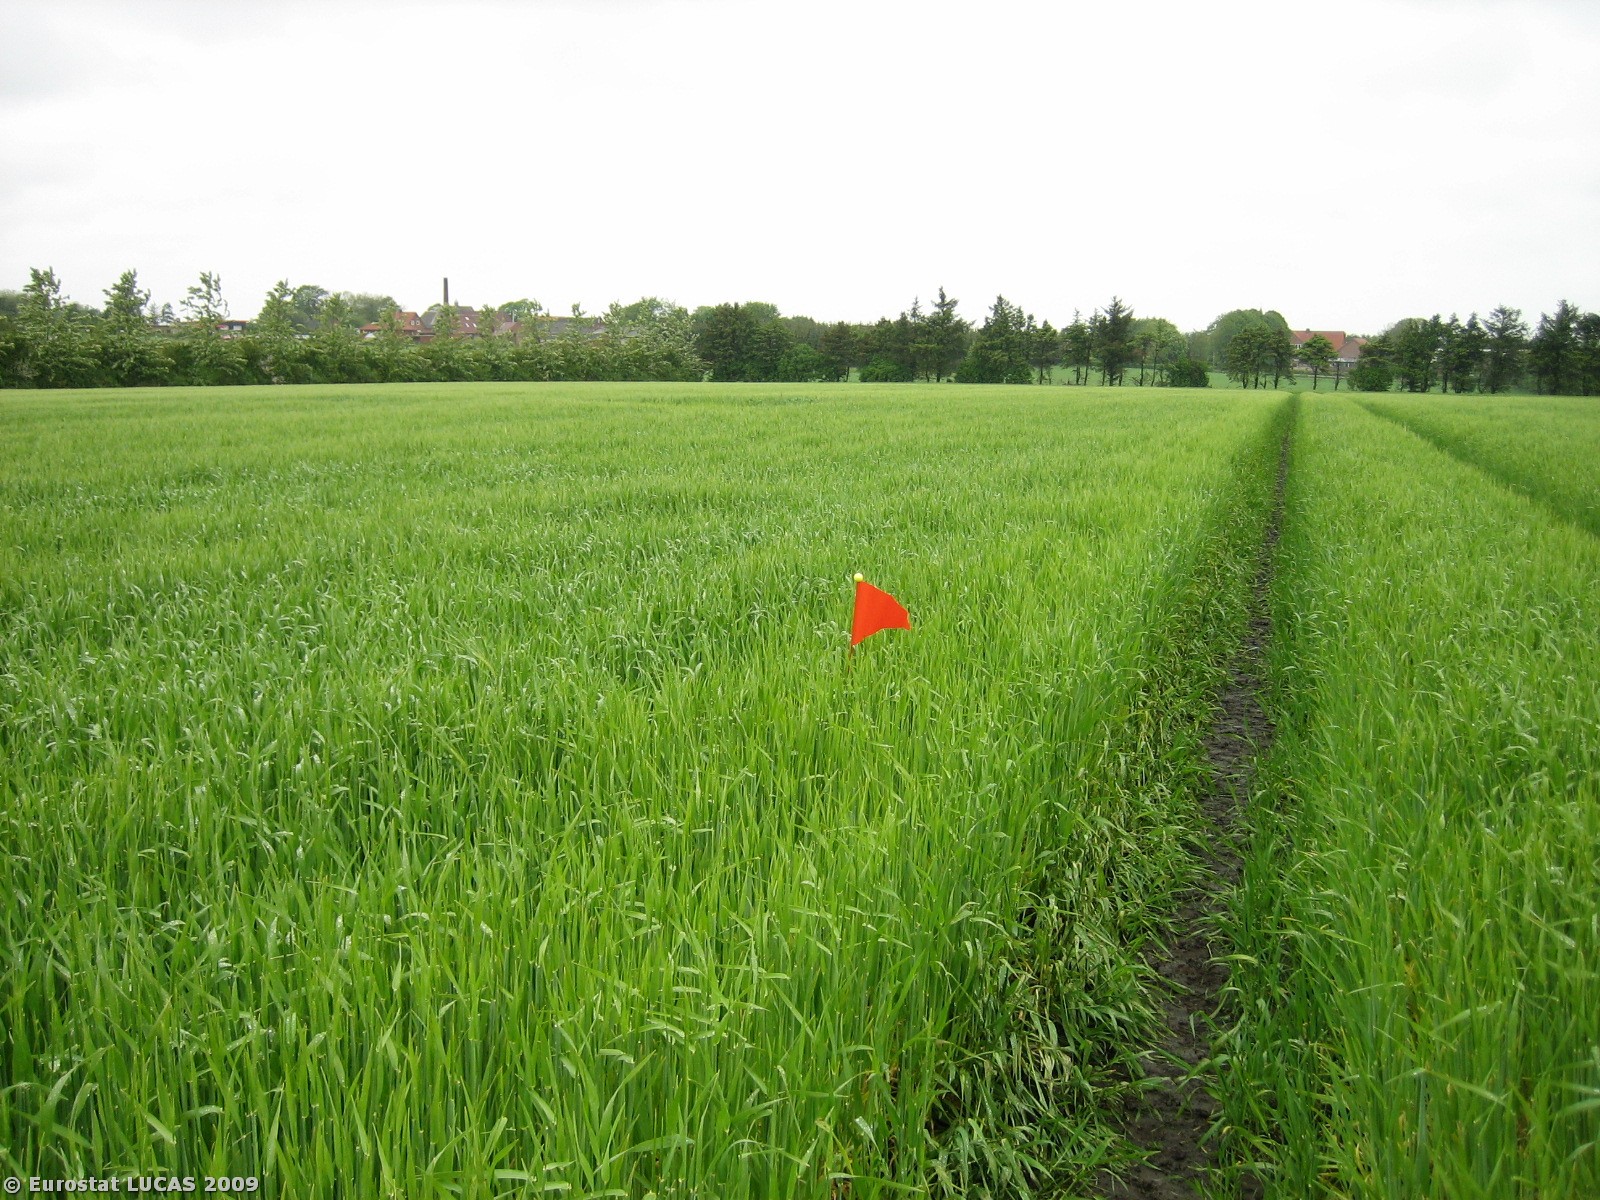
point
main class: Cropland
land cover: Barley
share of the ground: > 75 %
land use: Agriculture (excluding fallow land and kitchen gardens)
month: May
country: DK
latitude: 56.0532
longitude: 8.5083
